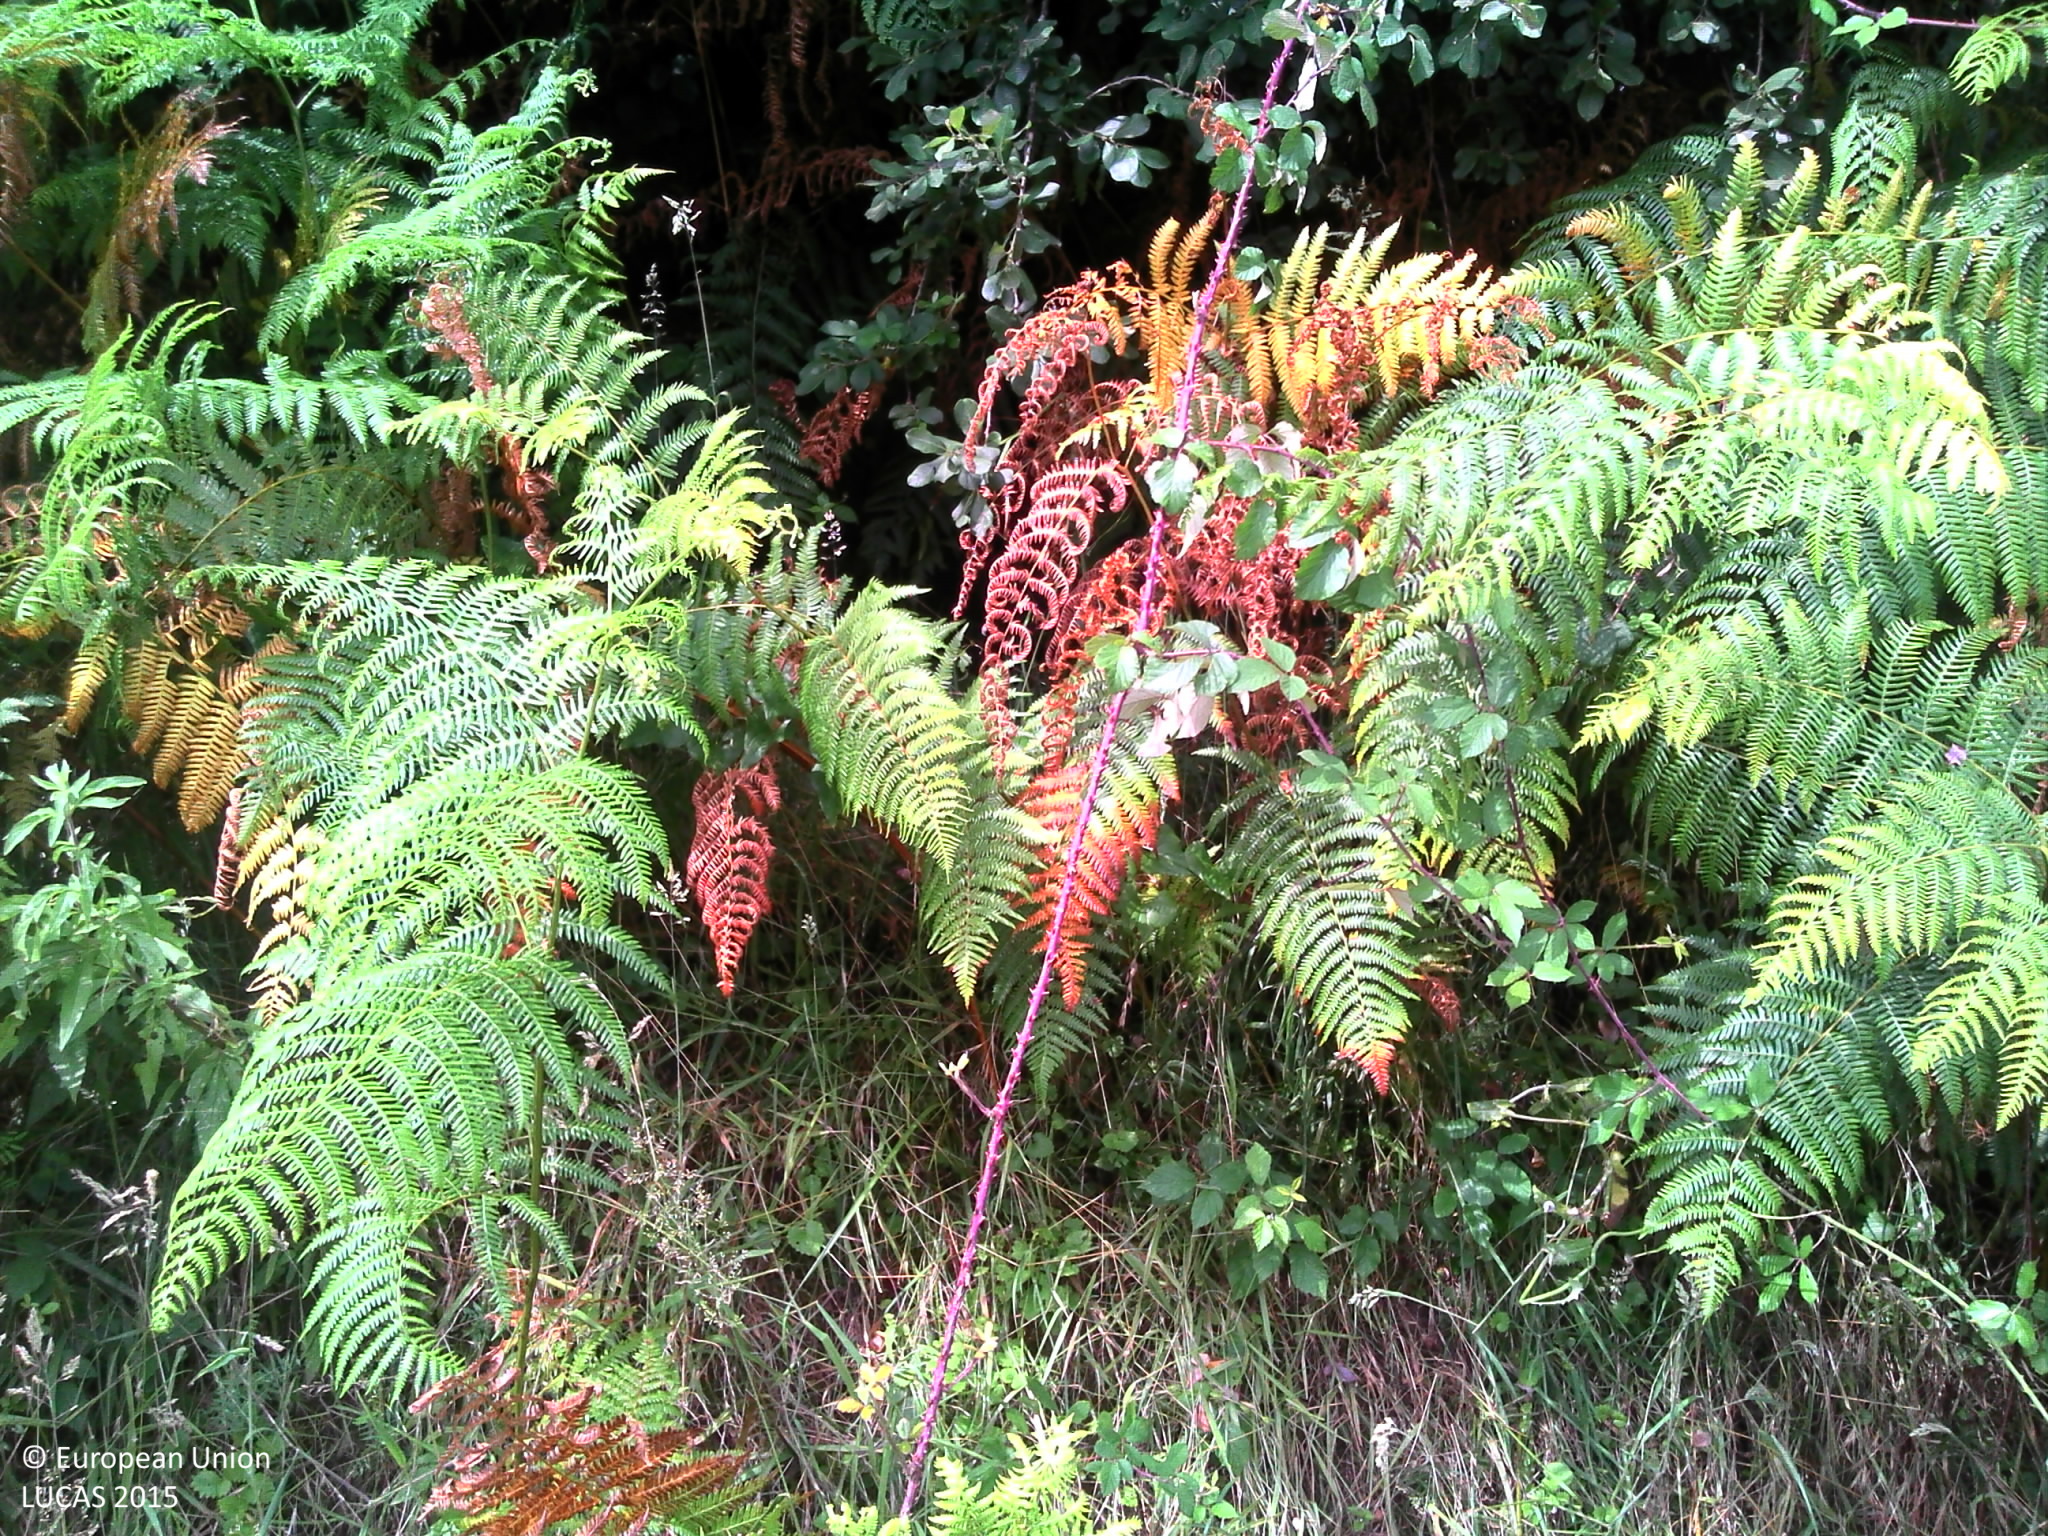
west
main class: Shrubland
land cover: Shrubland with sparse tree cover
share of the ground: > 75 %
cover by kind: shrubs 90 %, broadleaved forest trees 5 %, herbaceous plants 5 %
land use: Semi-natural and natural areas not in use
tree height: > 5 m
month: July
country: FR
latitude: 43.6082
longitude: -0.7540
